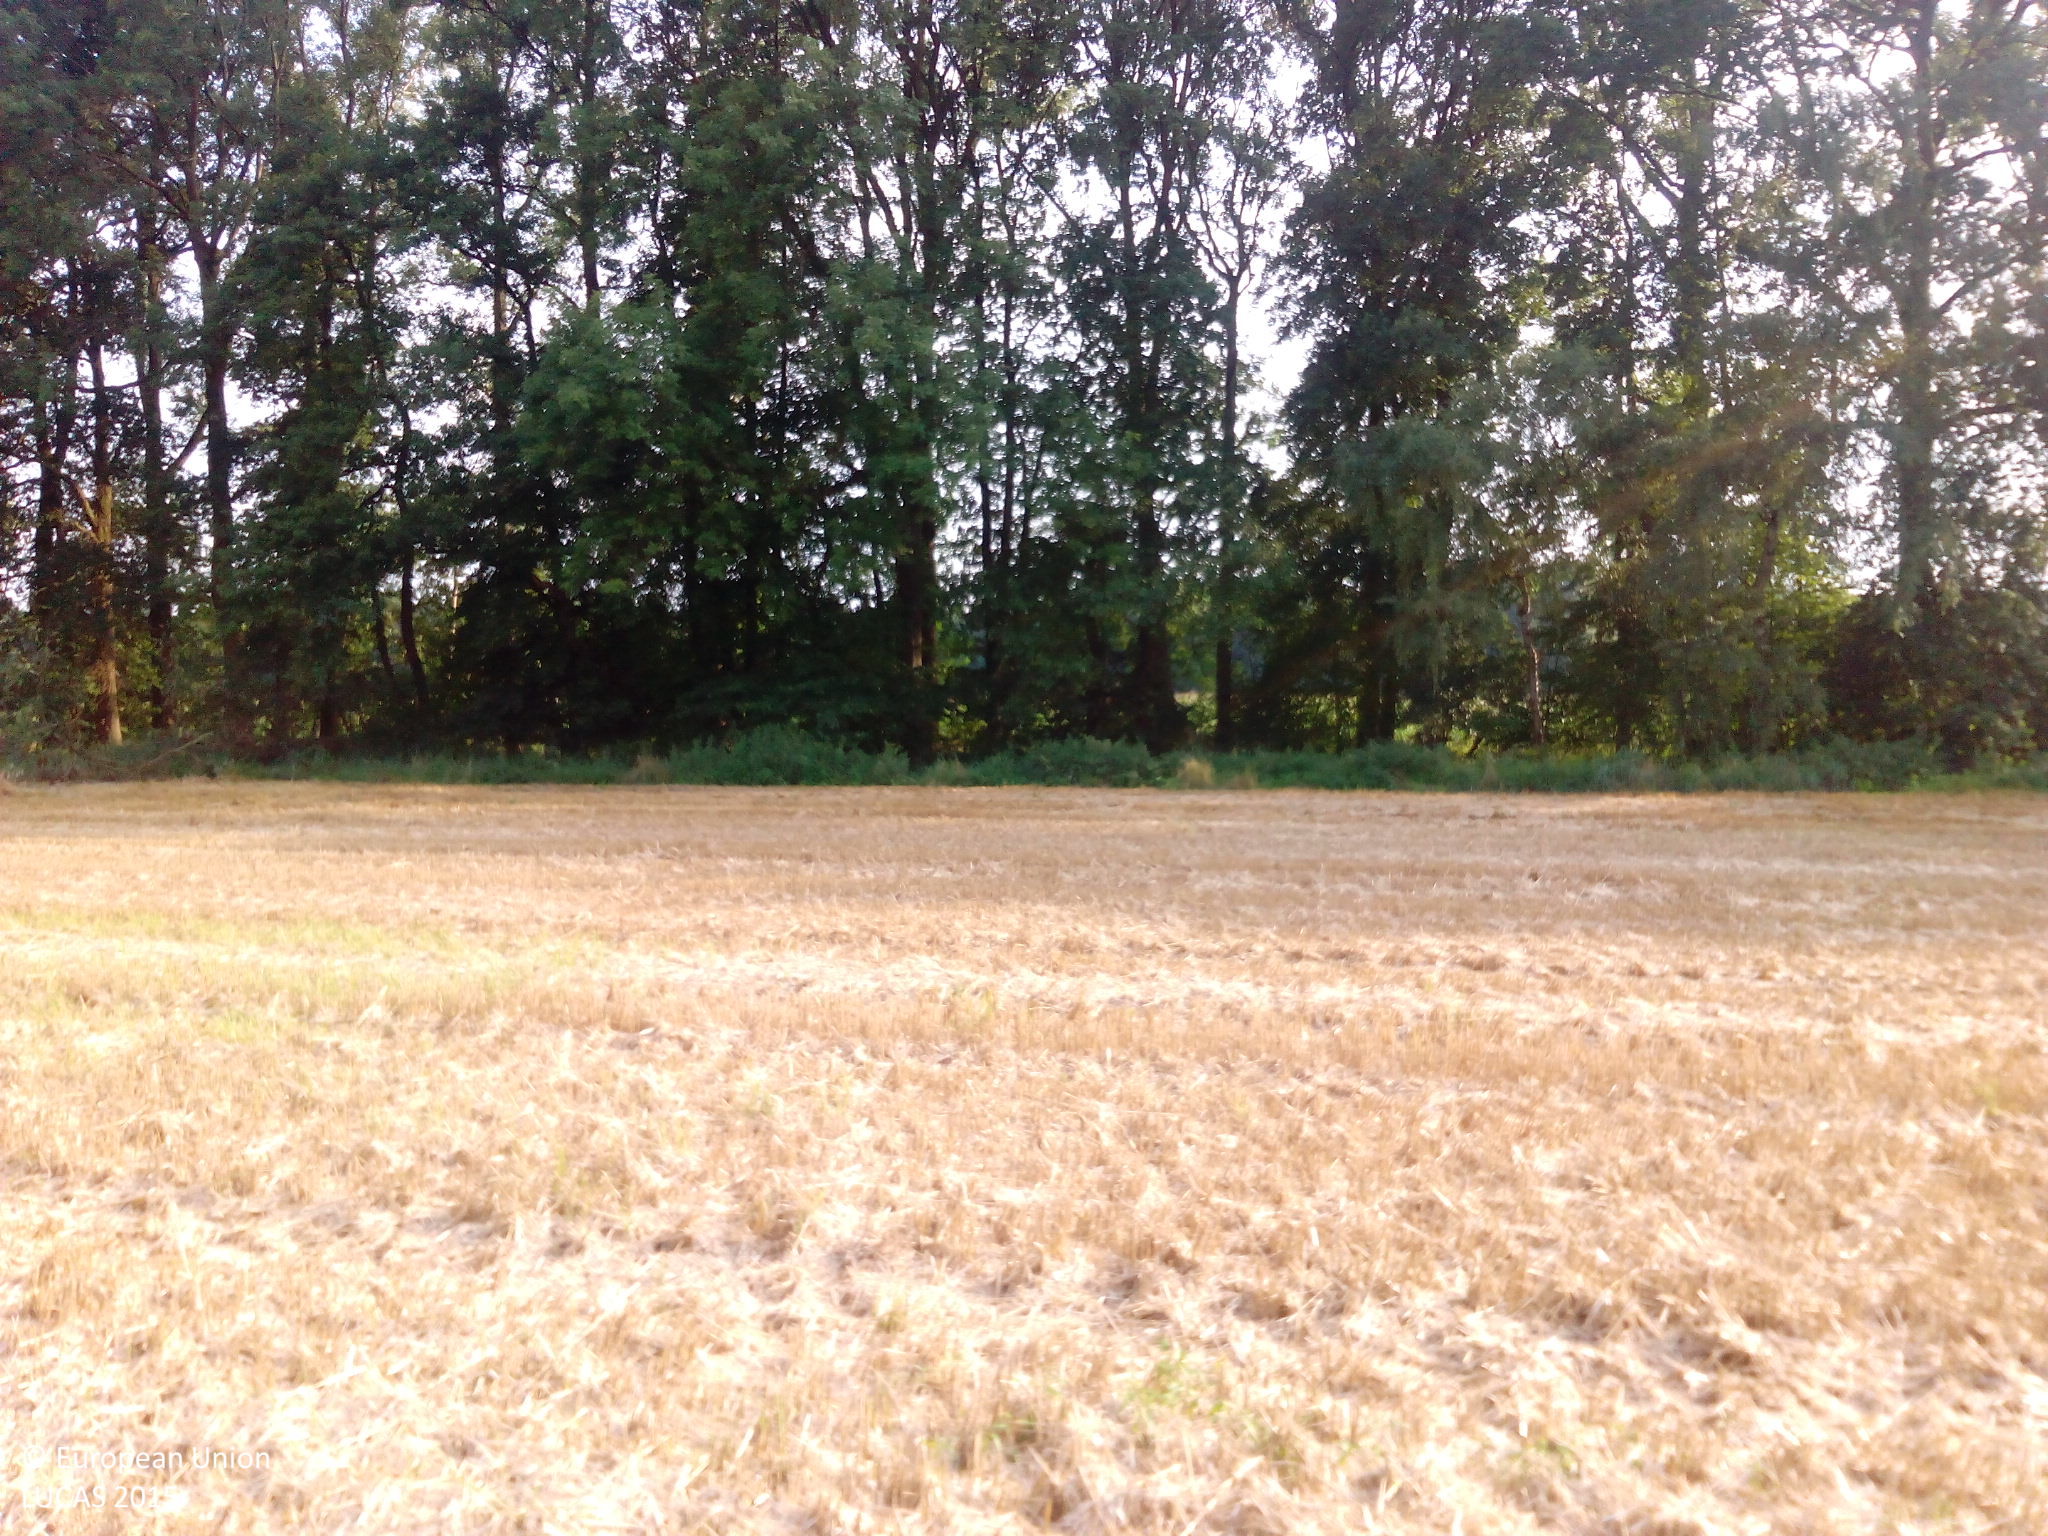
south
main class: Cropland
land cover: Barley
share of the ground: 50 - 75 %
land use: Agriculture (excluding fallow land and kitchen gardens)
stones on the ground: < 10 %
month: August
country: DE
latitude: 52.1094
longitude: 8.0292
